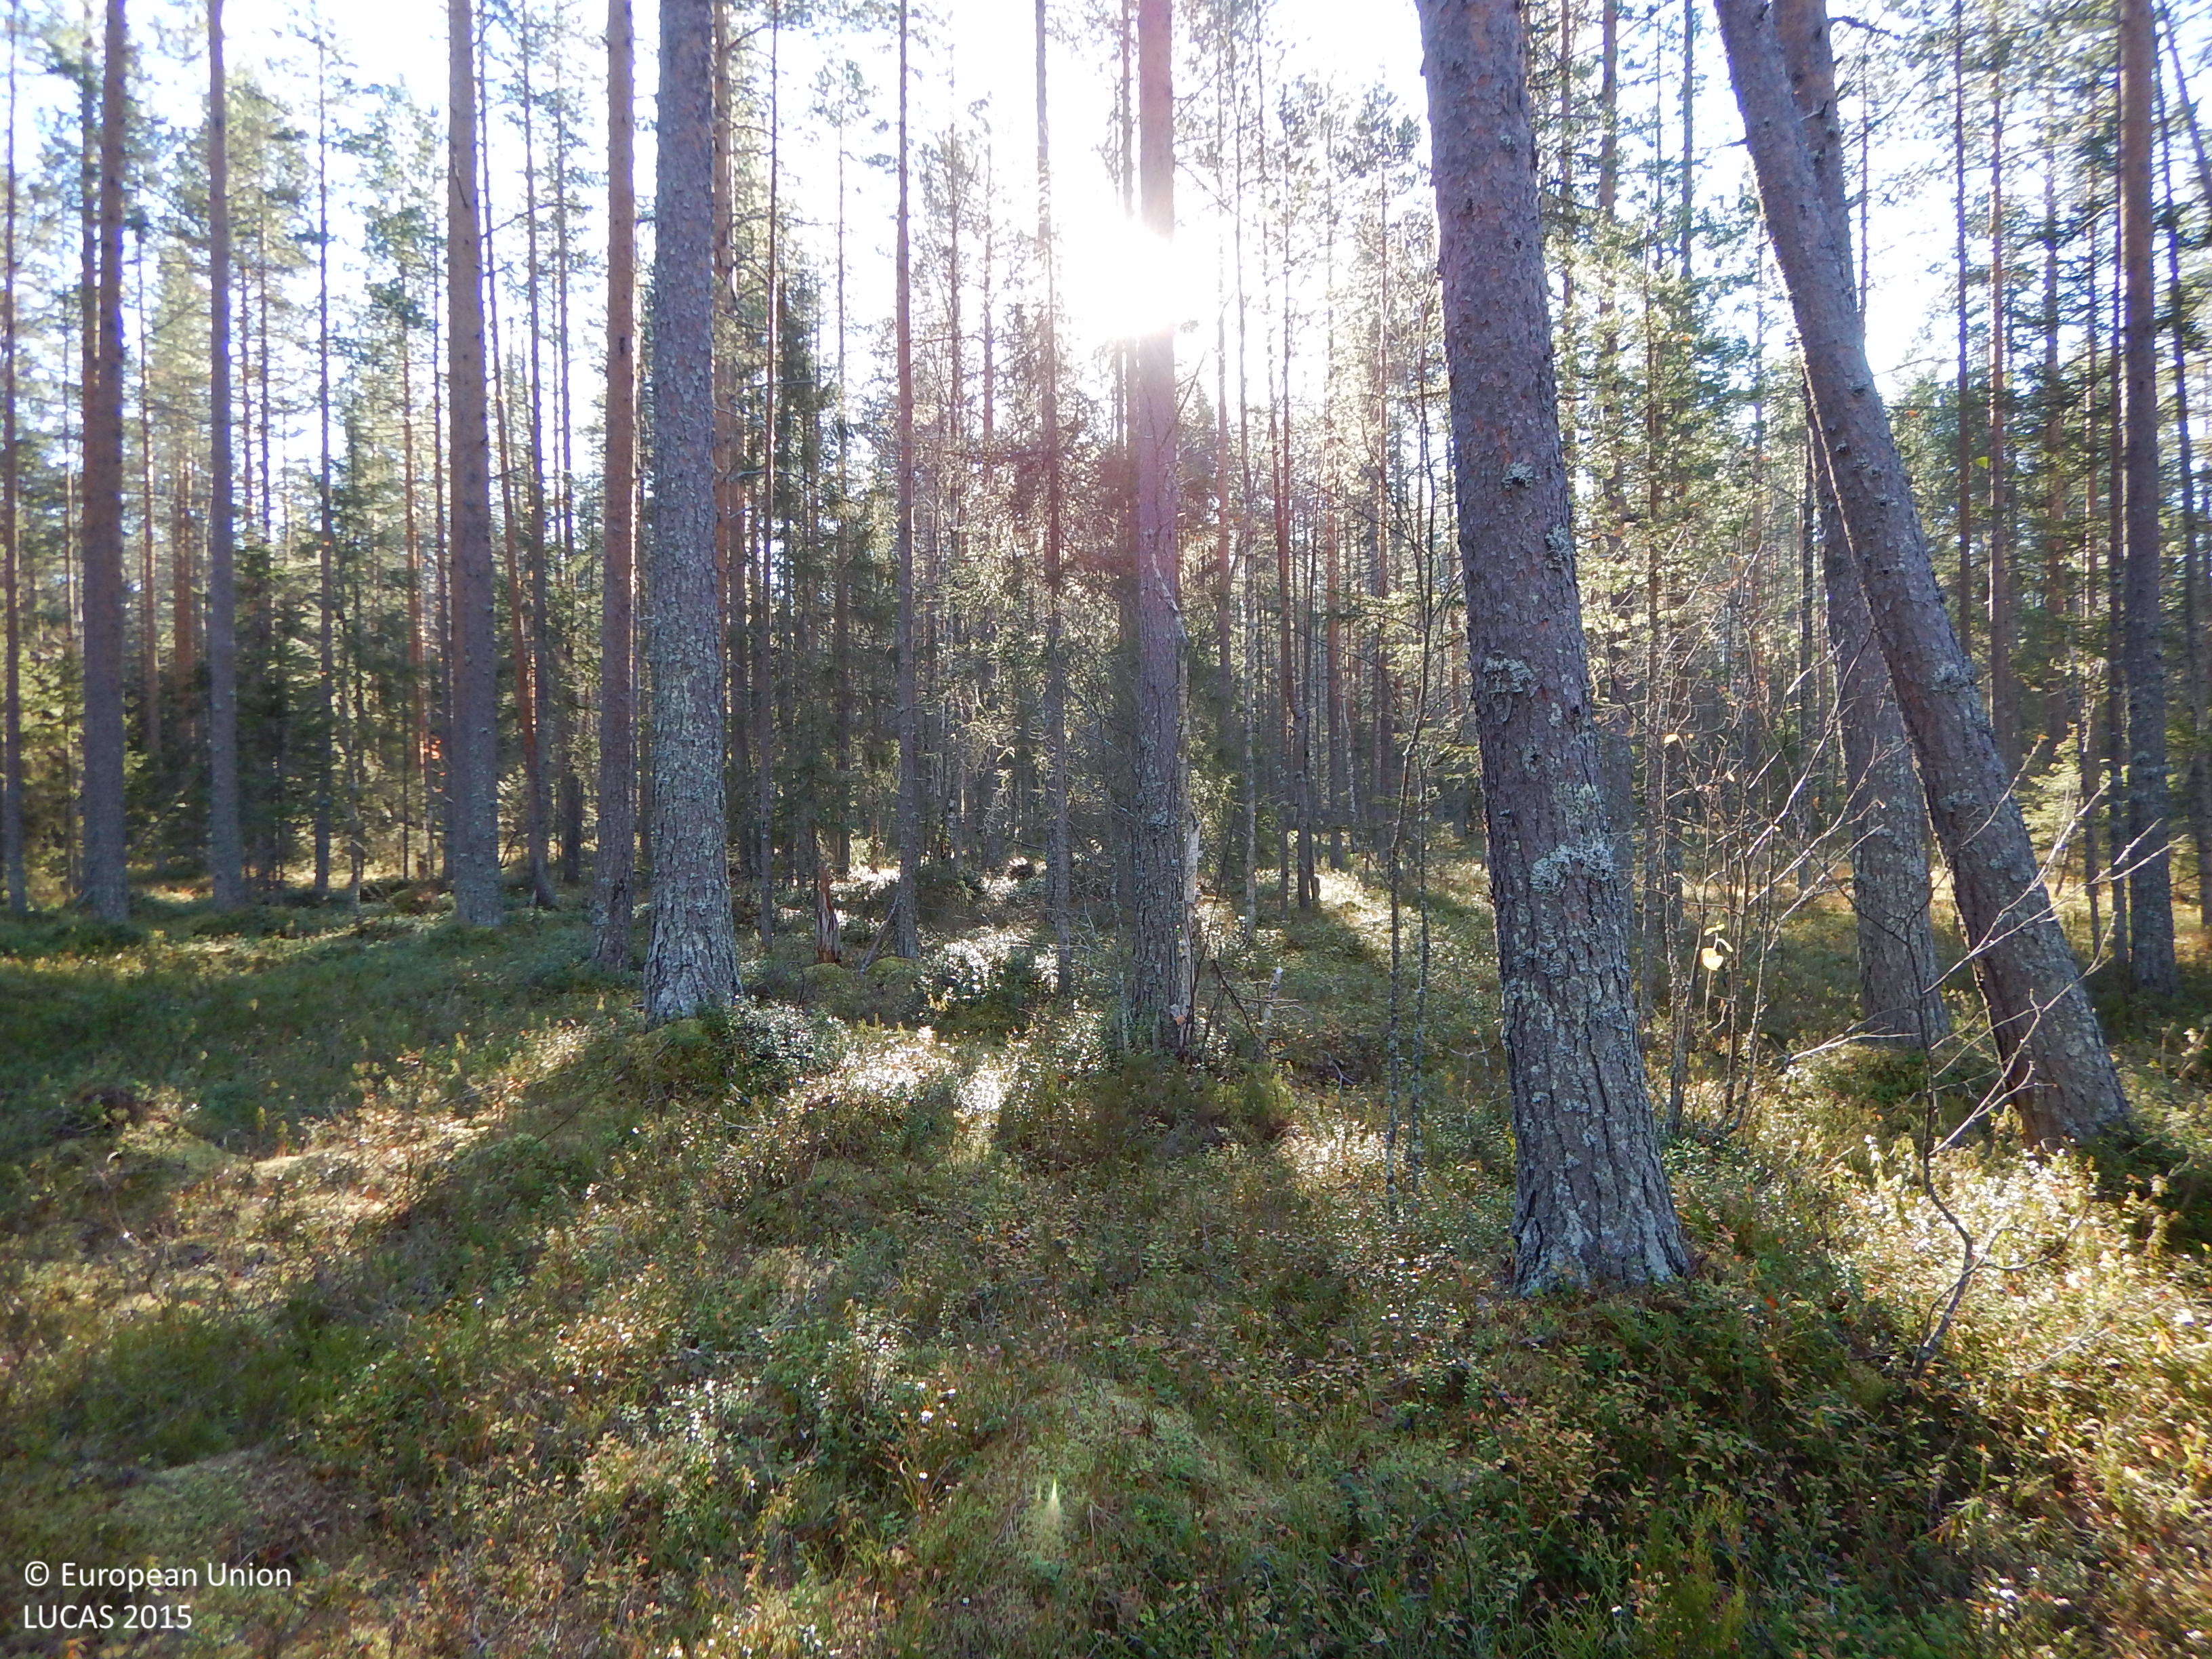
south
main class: Woodland
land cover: Pine dominated coniferous woodland
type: boreal forest
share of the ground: 50 - 75 %
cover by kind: coniferous forest trees 60 %, shrubs 15 %, lichens and mosses 15 %, broadleaved forest trees 5 %, herbaceous plants 5 %
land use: Forestry
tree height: > 5 m
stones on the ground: < 10 %
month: October
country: SE
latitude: 65.0476
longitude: 21.1296
